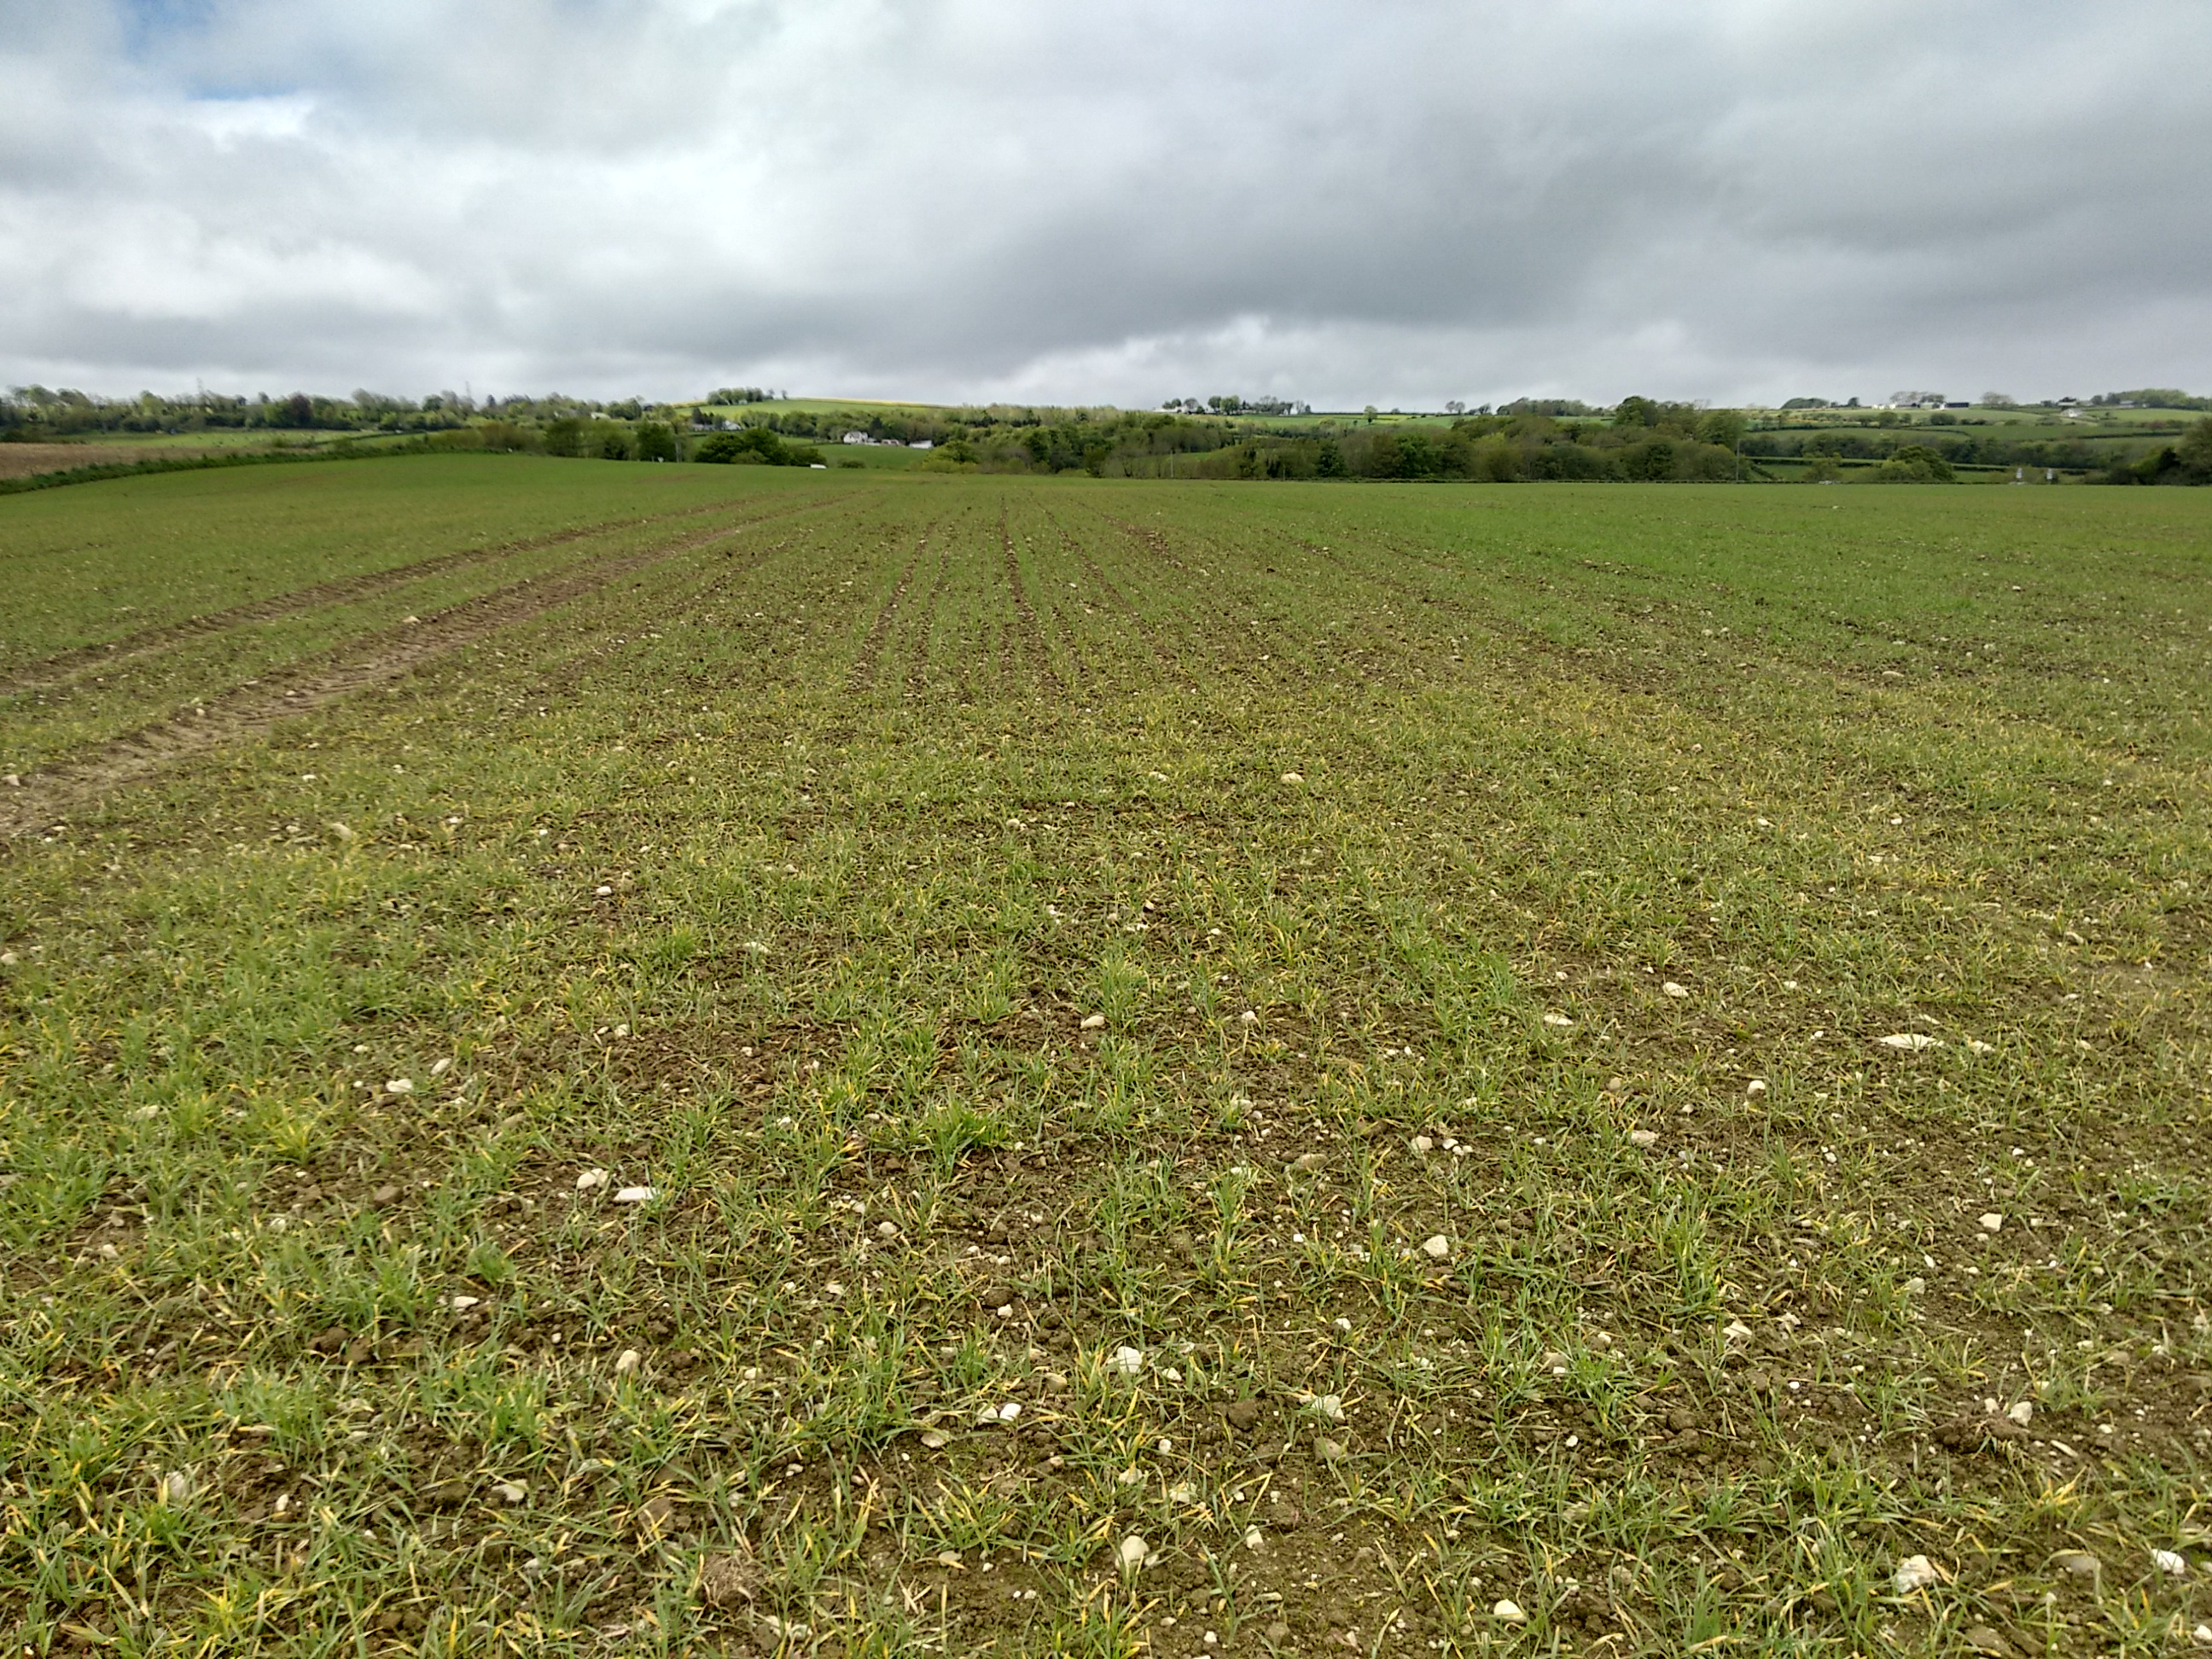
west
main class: Cropland
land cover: Barley
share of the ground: > 75 %
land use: Agriculture (excluding fallow land and kitchen gardens)
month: May
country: GB
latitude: 55.0162
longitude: -7.1746
